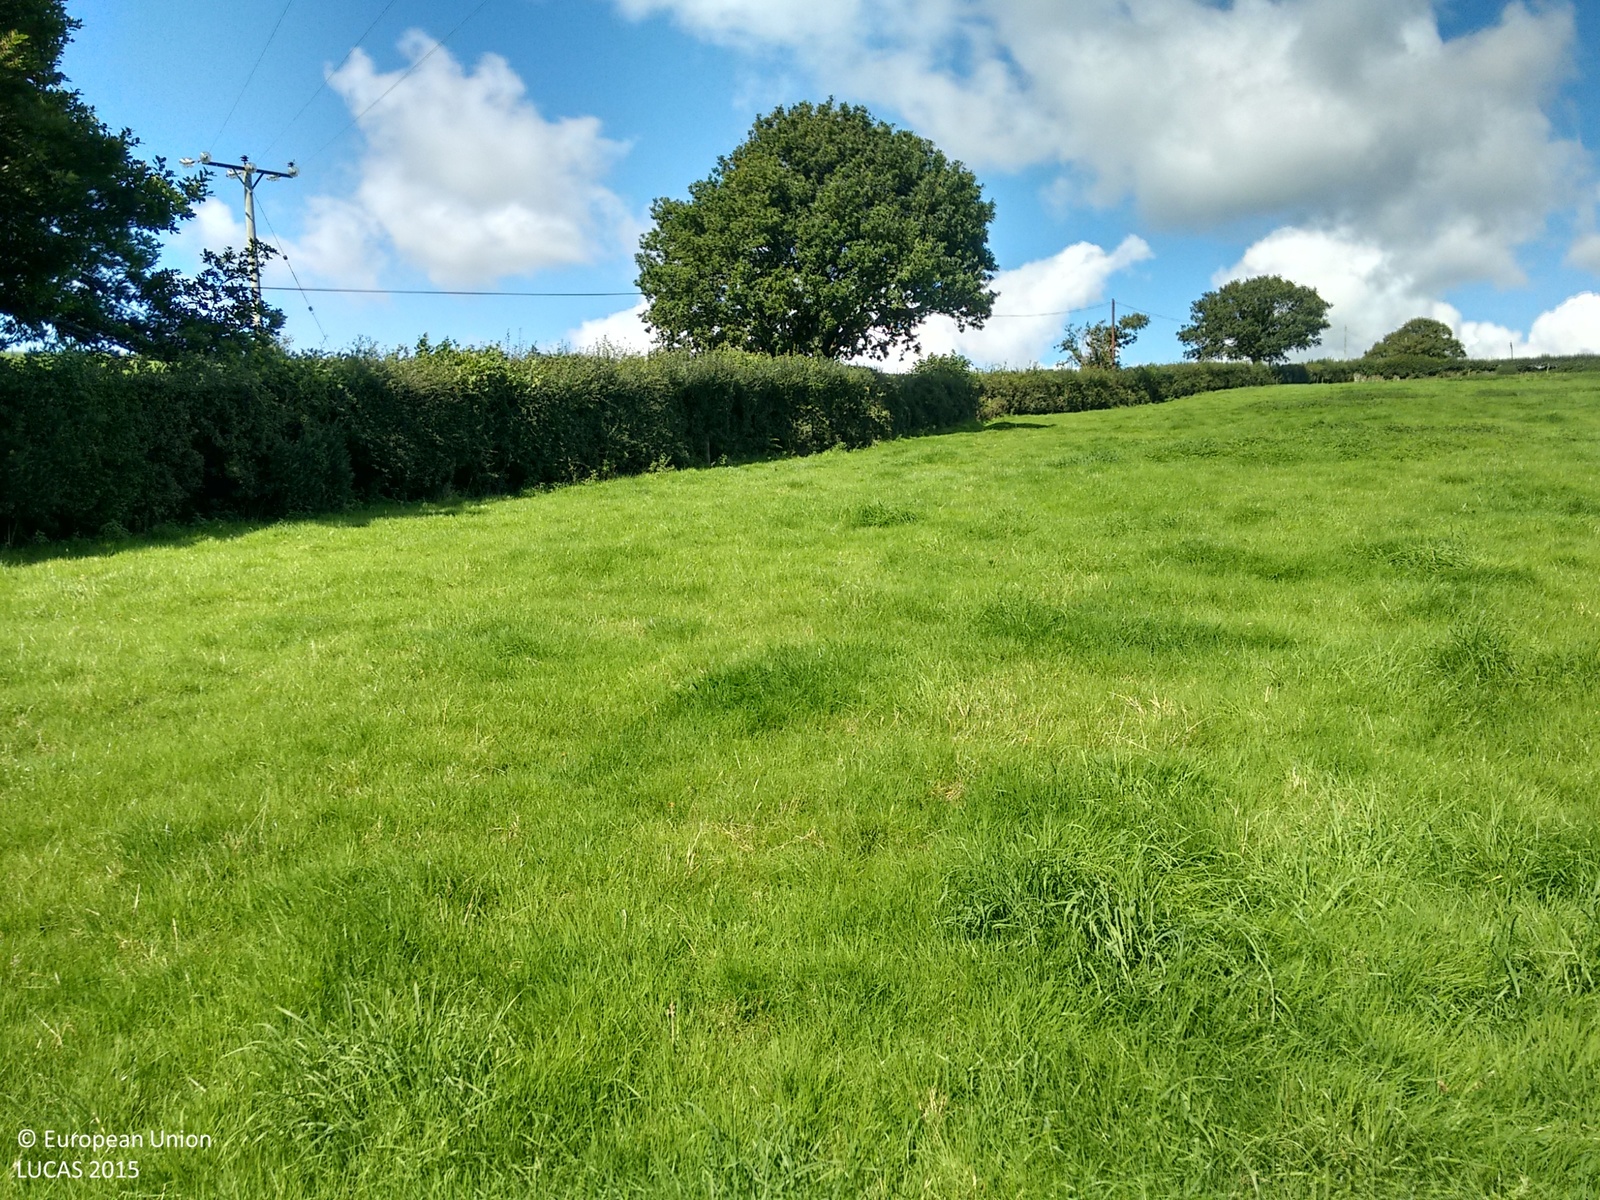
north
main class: Grassland
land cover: Grassland without tree/shrub cover
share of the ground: > 75 %
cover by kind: herbaceous plants 100 %
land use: Agriculture (excluding fallow land and kitchen gardens)
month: September
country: GB
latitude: 50.5714
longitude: -4.3190
